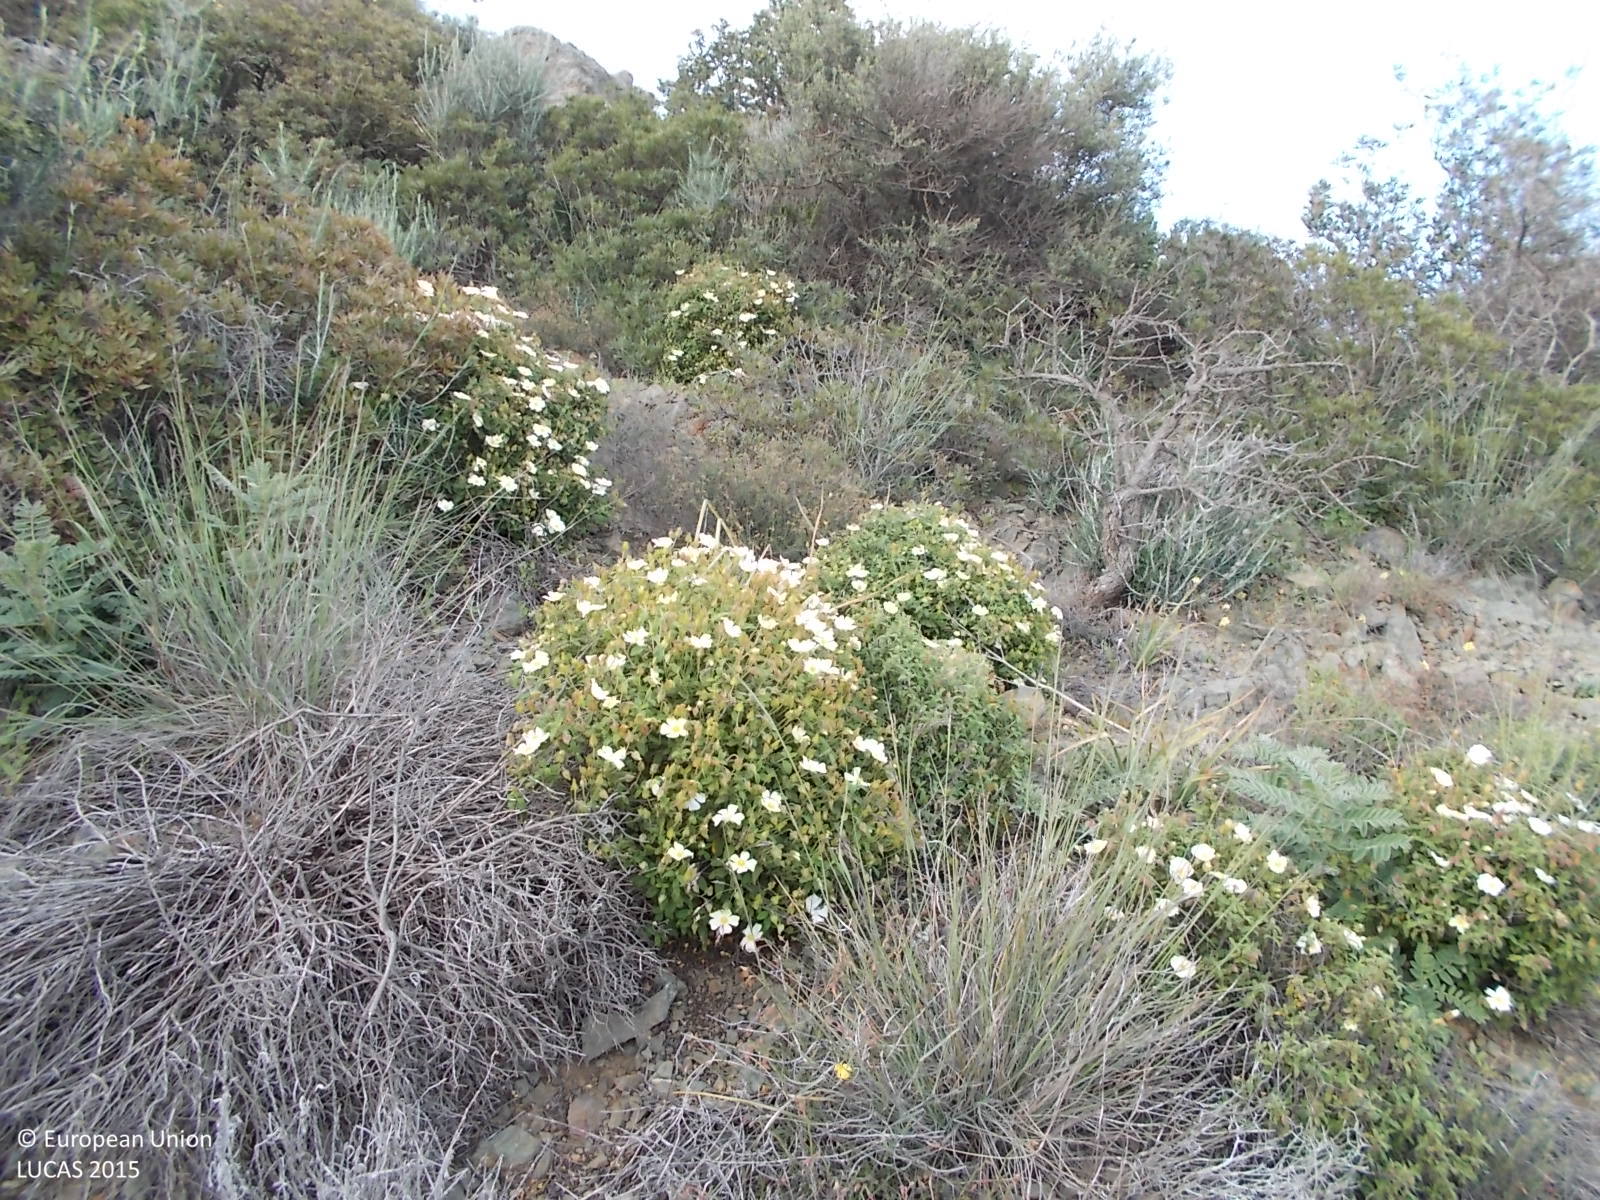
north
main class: Shrubland
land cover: Shrubland without tree cover
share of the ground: > 75 %
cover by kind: shrubs 85 %, unconsolidated bare surface 15 %
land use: Semi-natural and natural areas not in use
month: April
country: CY
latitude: 34.8871
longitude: 33.4388
